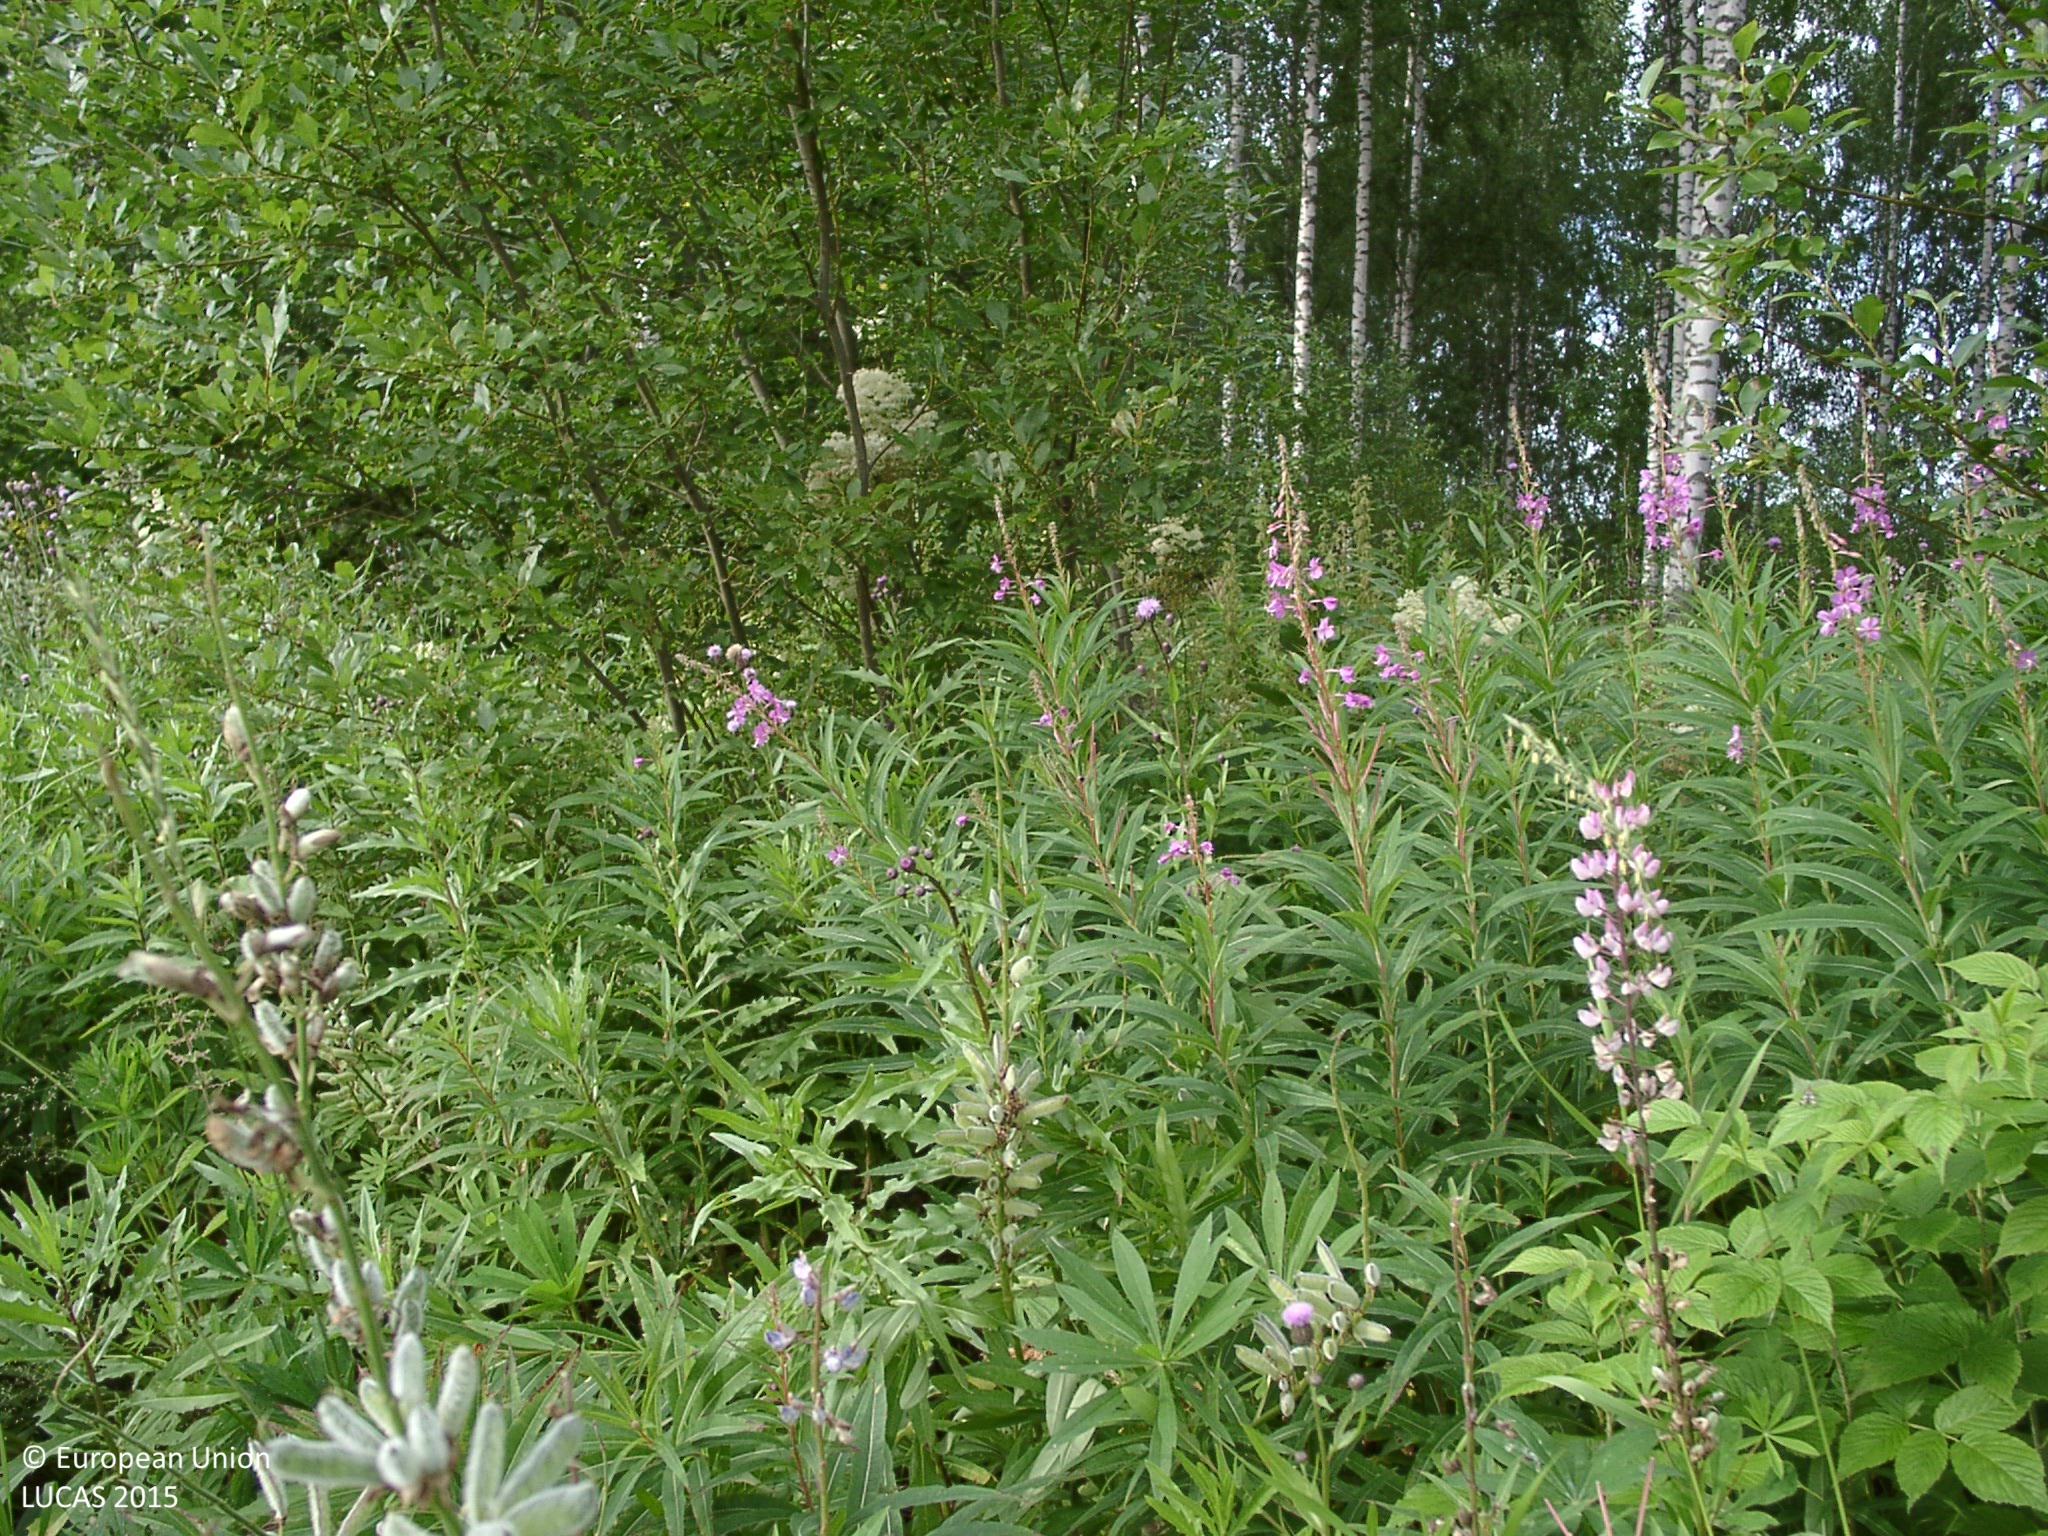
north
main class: Grassland
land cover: Grassland without tree/shrub cover
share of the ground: > 75 %
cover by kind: herbaceous plants 95 %, shrubs 5 %
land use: Road transport
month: July
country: FI
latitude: 62.2958
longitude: 25.7173
